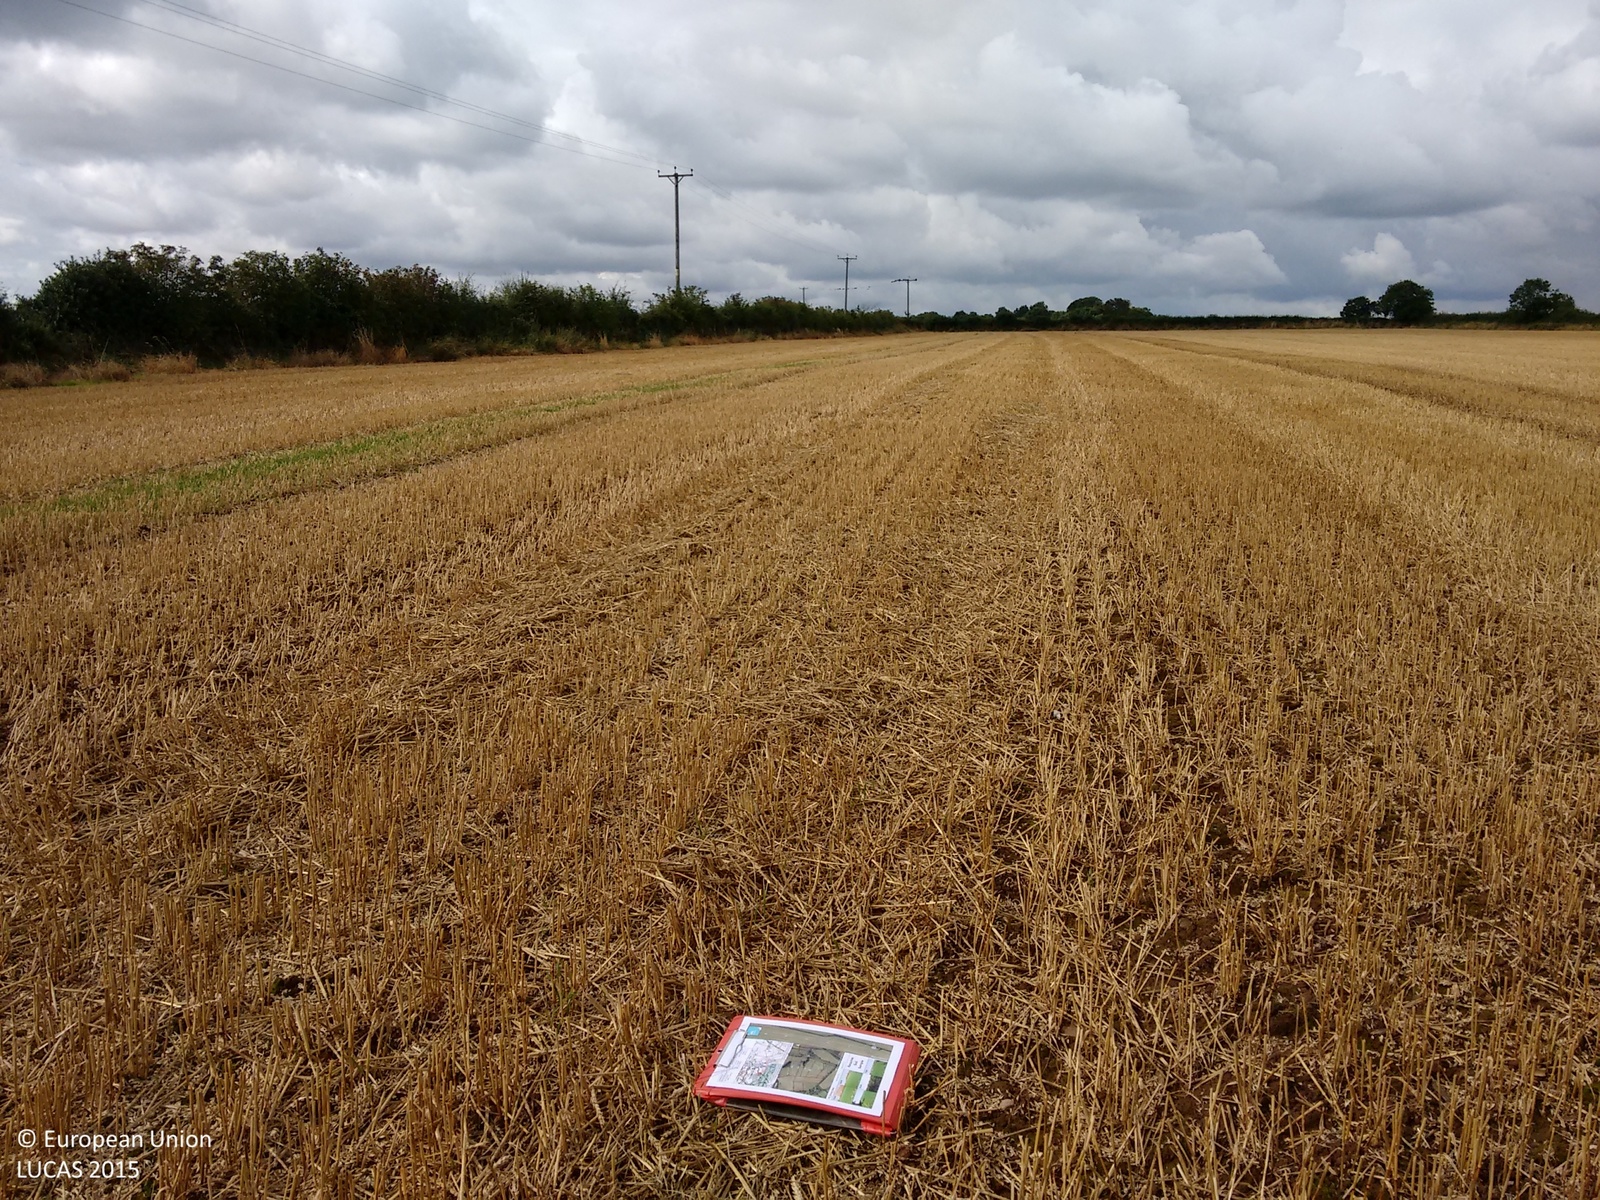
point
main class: Cropland
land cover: Common wheat
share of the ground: > 75 %
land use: Agriculture (excluding fallow land and kitchen gardens)
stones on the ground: < 10 %
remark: Harvested field
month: September
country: GB
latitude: 52.7867
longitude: -1.4224
